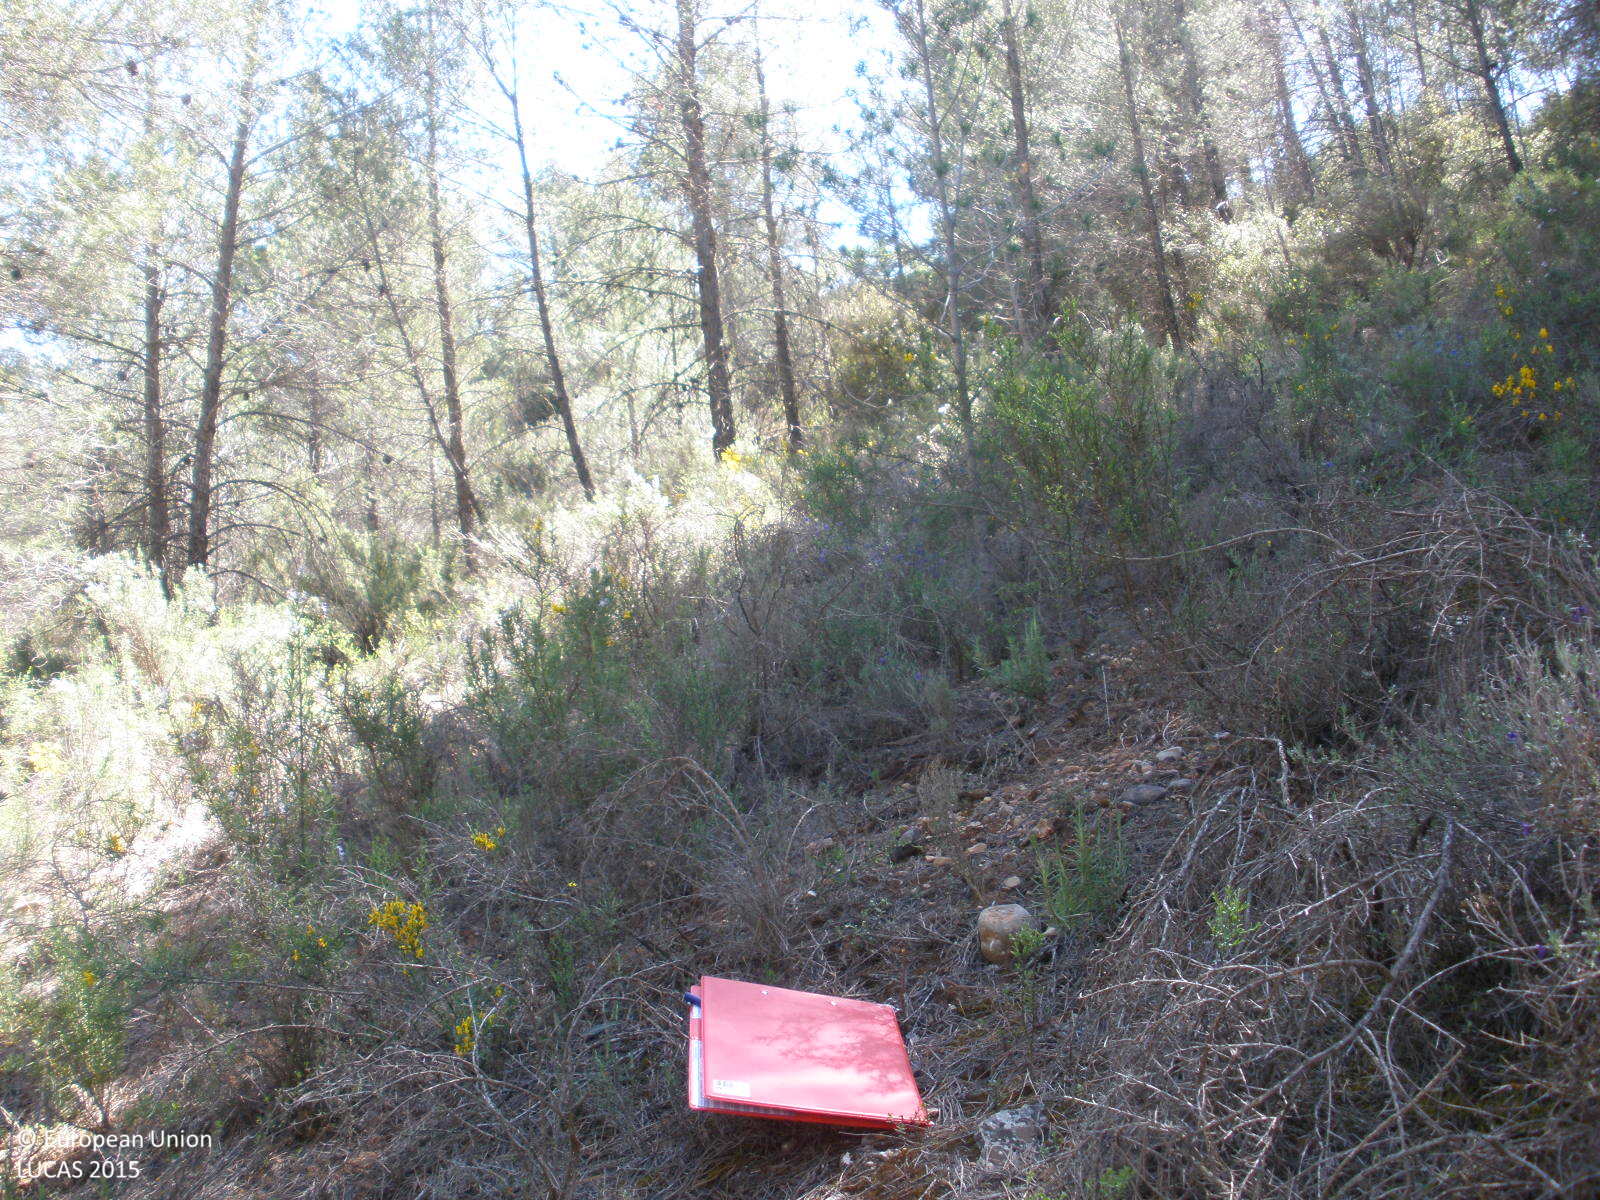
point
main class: Woodland
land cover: Pine dominated coniferous woodland
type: coniferous forest of the mediterranean region
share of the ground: 25 - 50 %
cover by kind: shrubs 60 %, coniferous forest trees 40 %
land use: Semi-natural and natural areas not in use
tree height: > 5 m
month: April
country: ES
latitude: 40.1302
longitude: -1.2402
